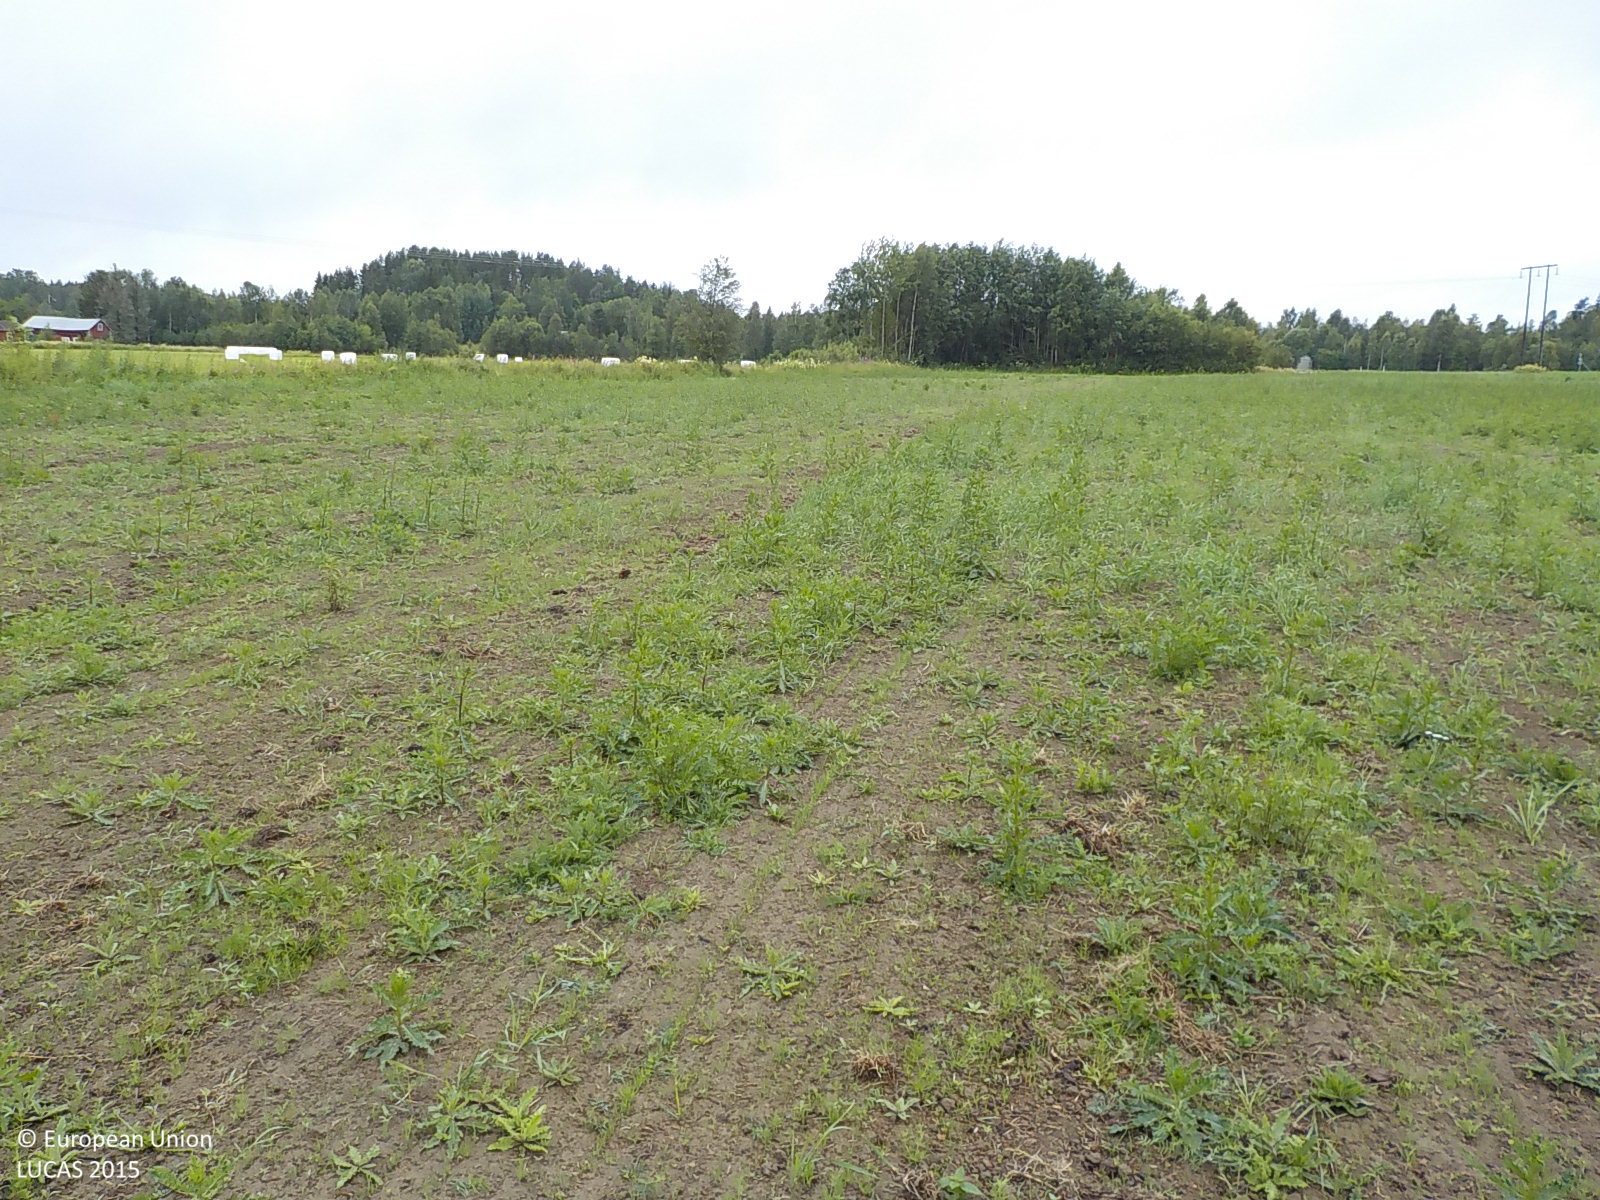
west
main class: Cropland
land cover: Other leguminous and mixtures for fodder
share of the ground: > 75 %
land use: Agriculture (excluding fallow land and kitchen gardens)
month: July
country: SE
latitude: 63.0255
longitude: 17.8226
